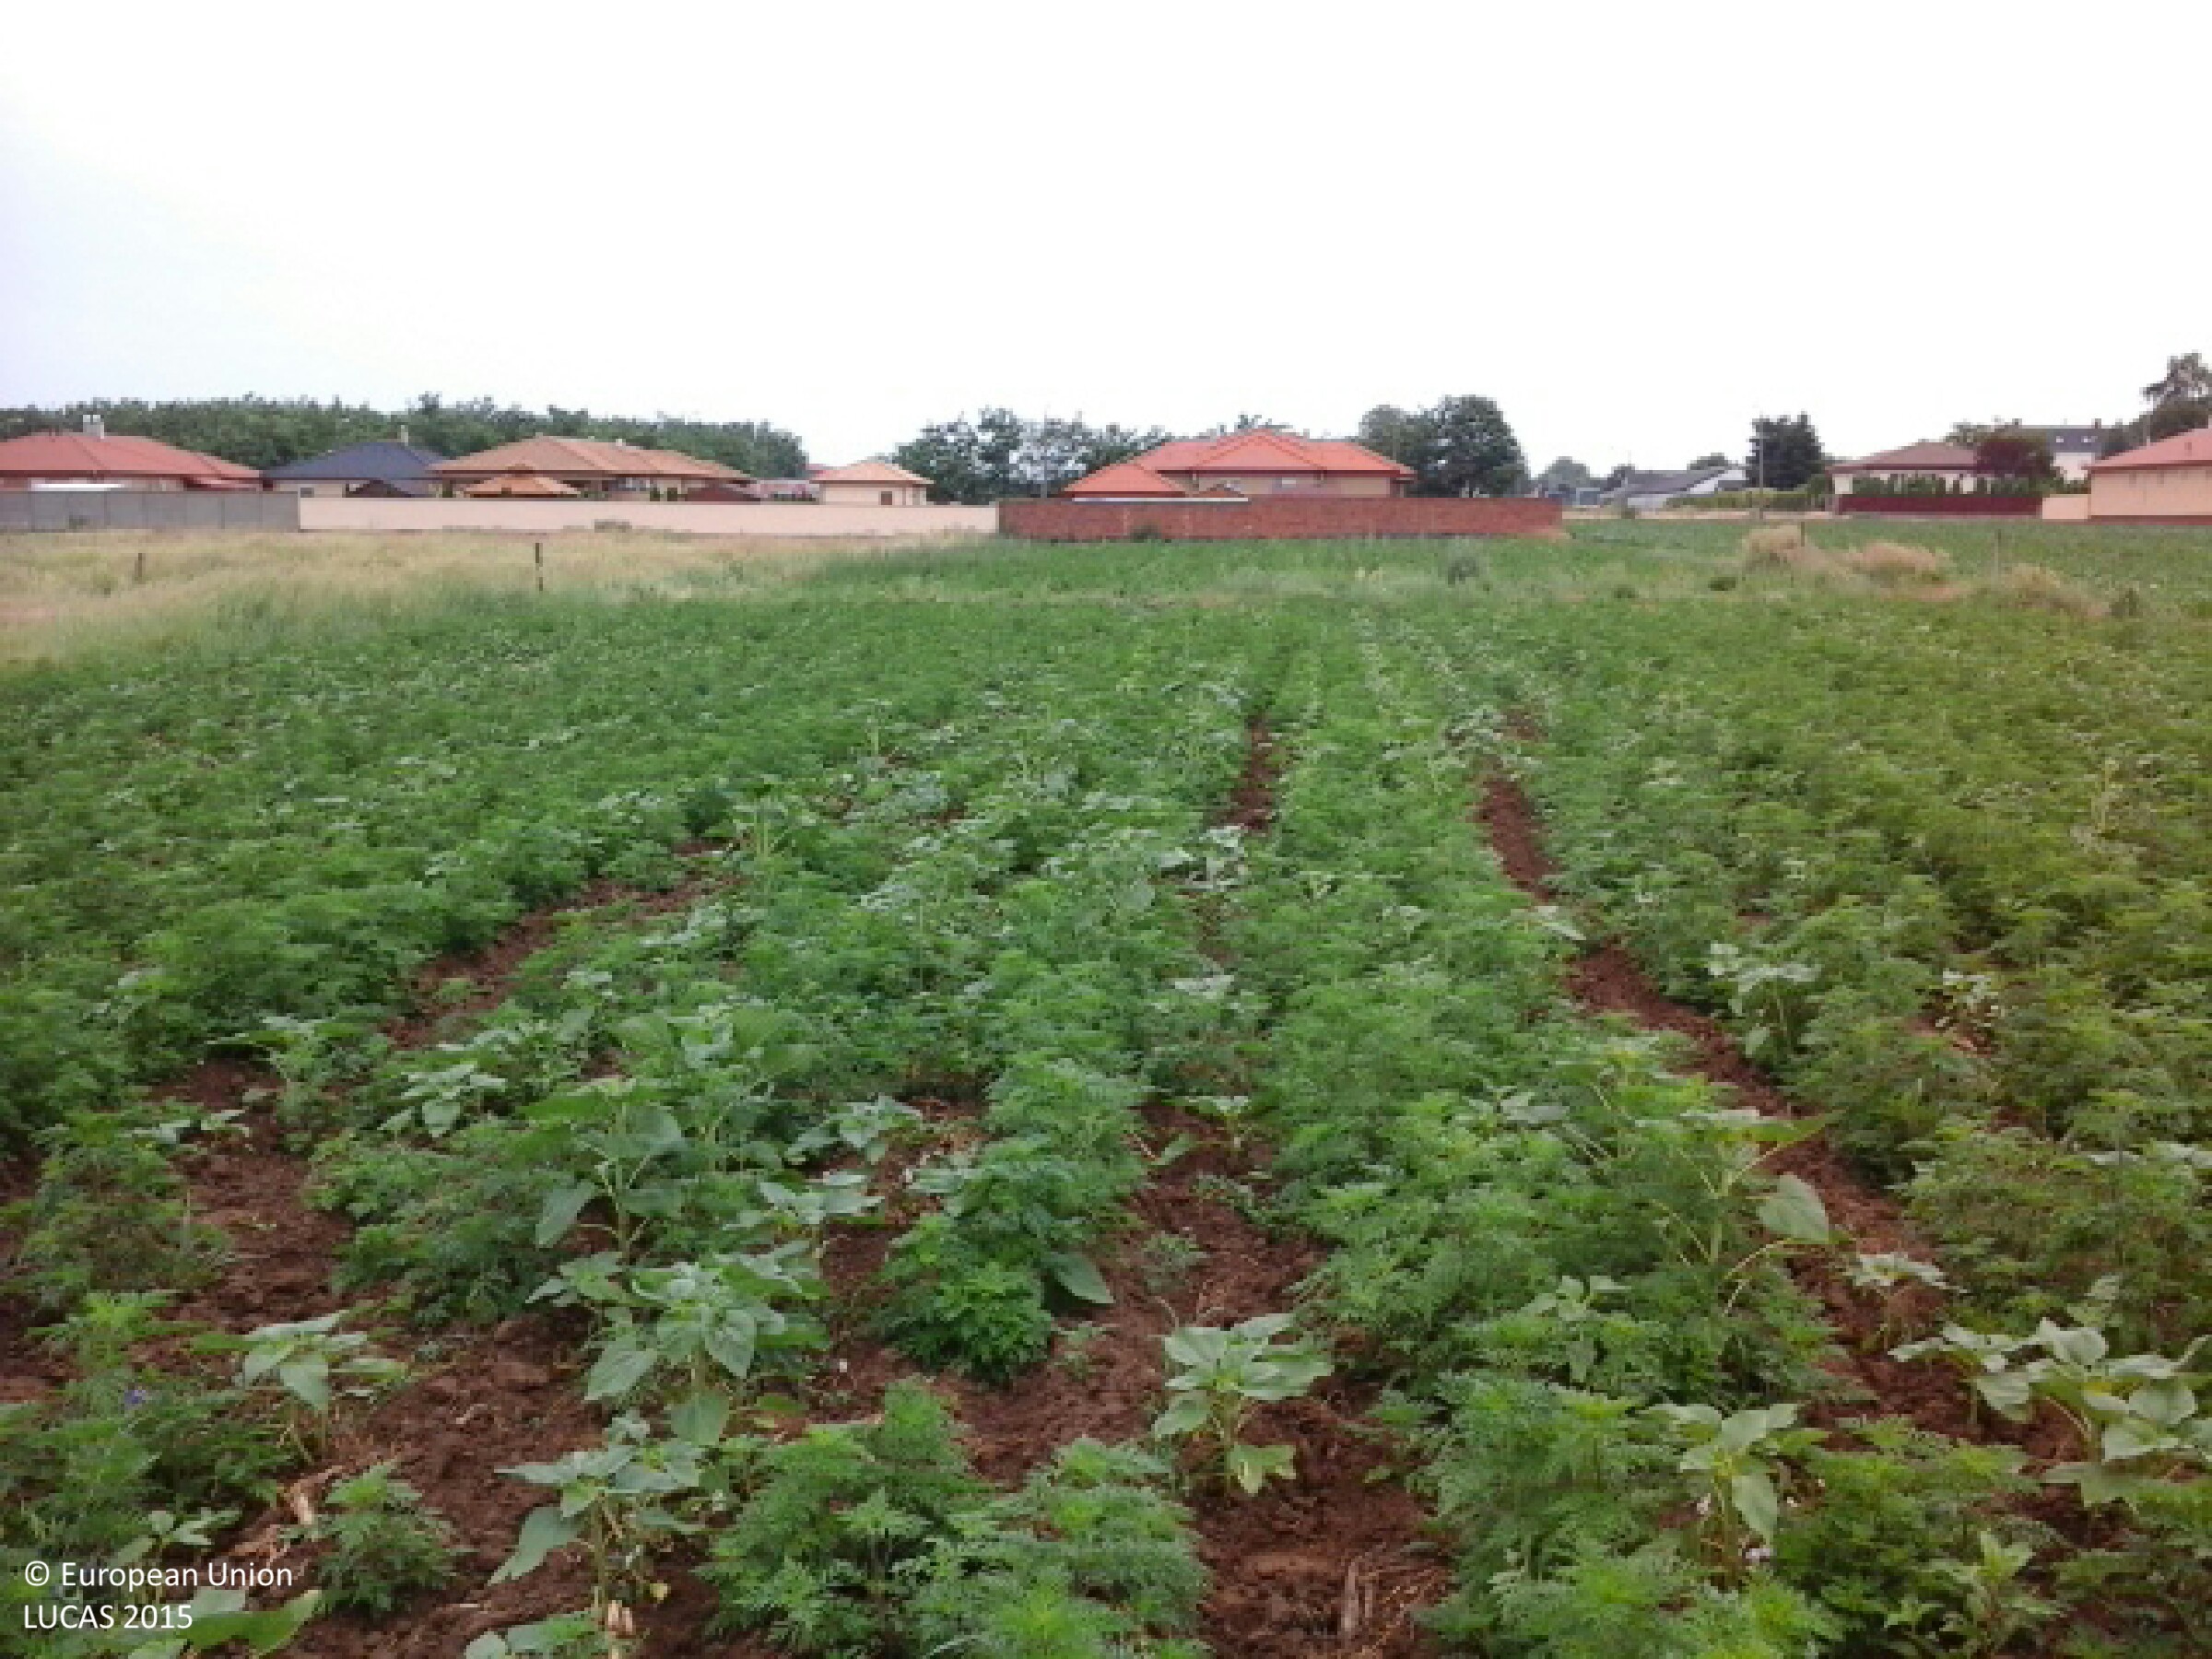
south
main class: Cropland
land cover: Sunflower
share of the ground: 10 - 25 %
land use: Agriculture (excluding fallow land and kitchen gardens)
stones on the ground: < 10 %
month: June
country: HU
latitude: 47.9547
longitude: 21.7655
